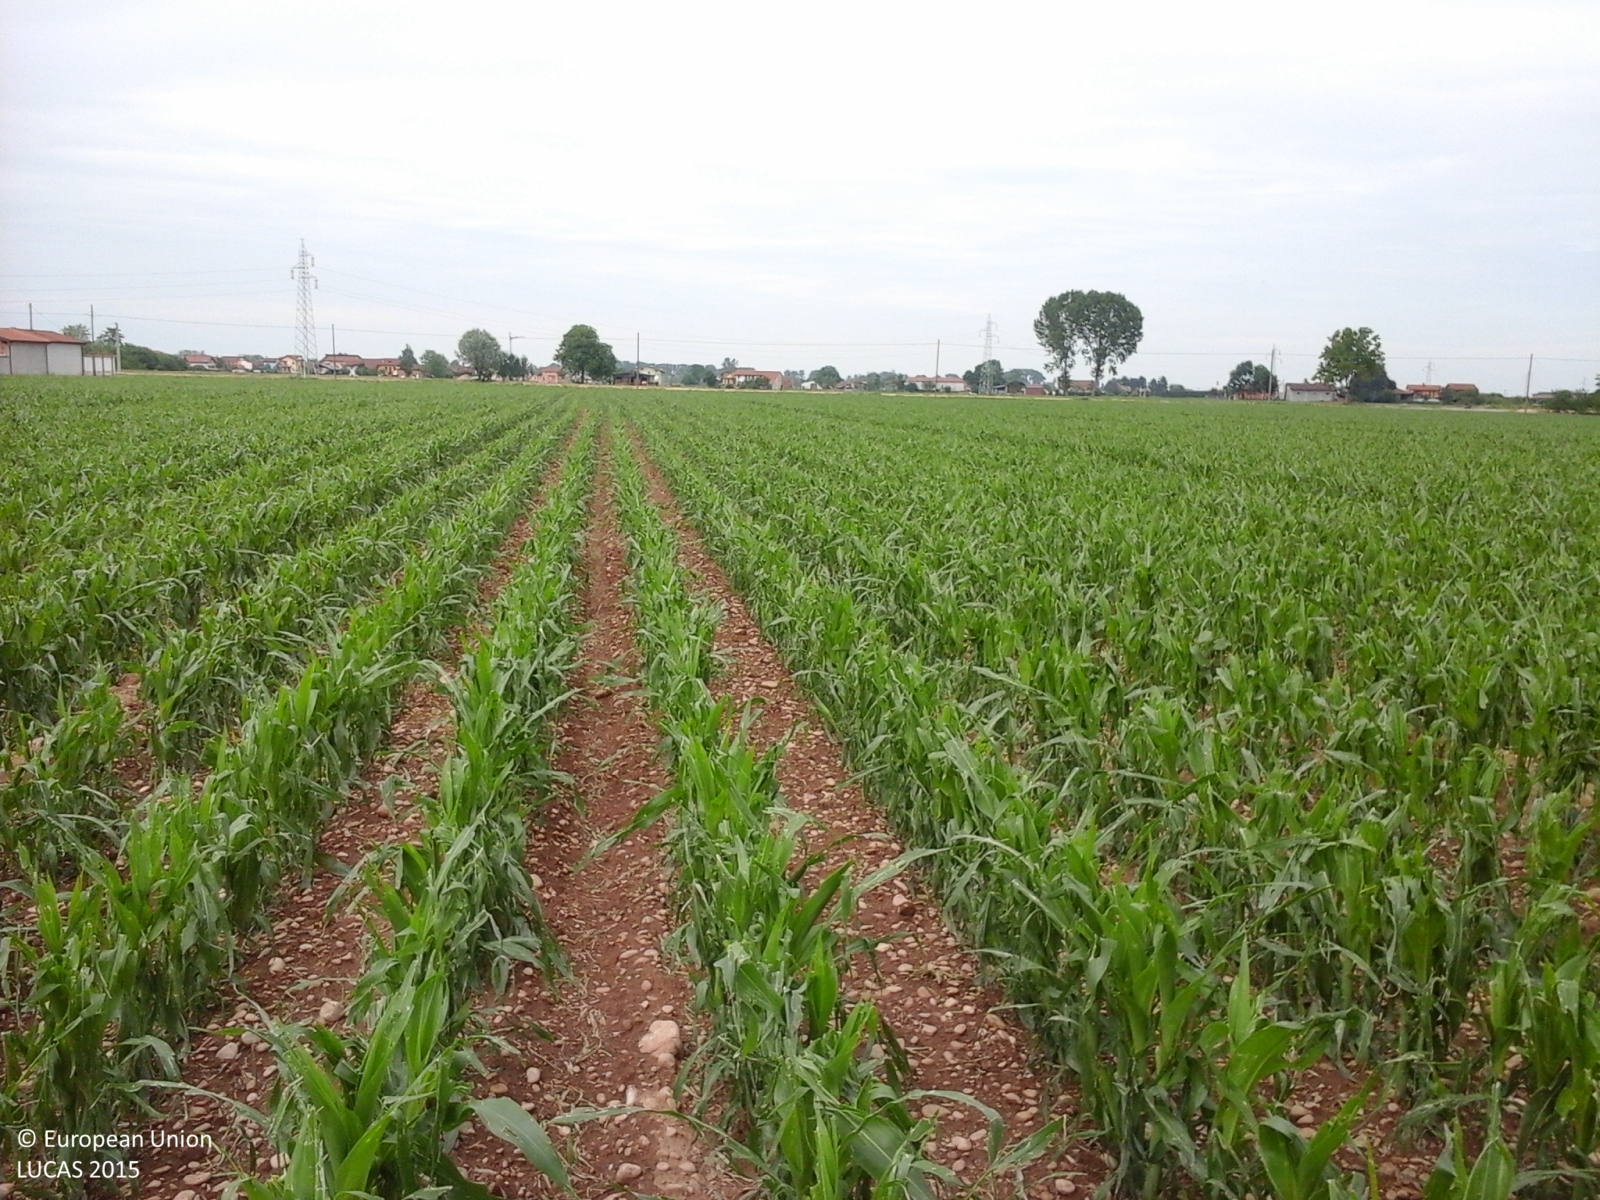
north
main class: Cropland
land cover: Maize
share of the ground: 25 - 50 %
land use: Agriculture (excluding fallow land and kitchen gardens)
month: May
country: IT
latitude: 44.5044
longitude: 7.6527
